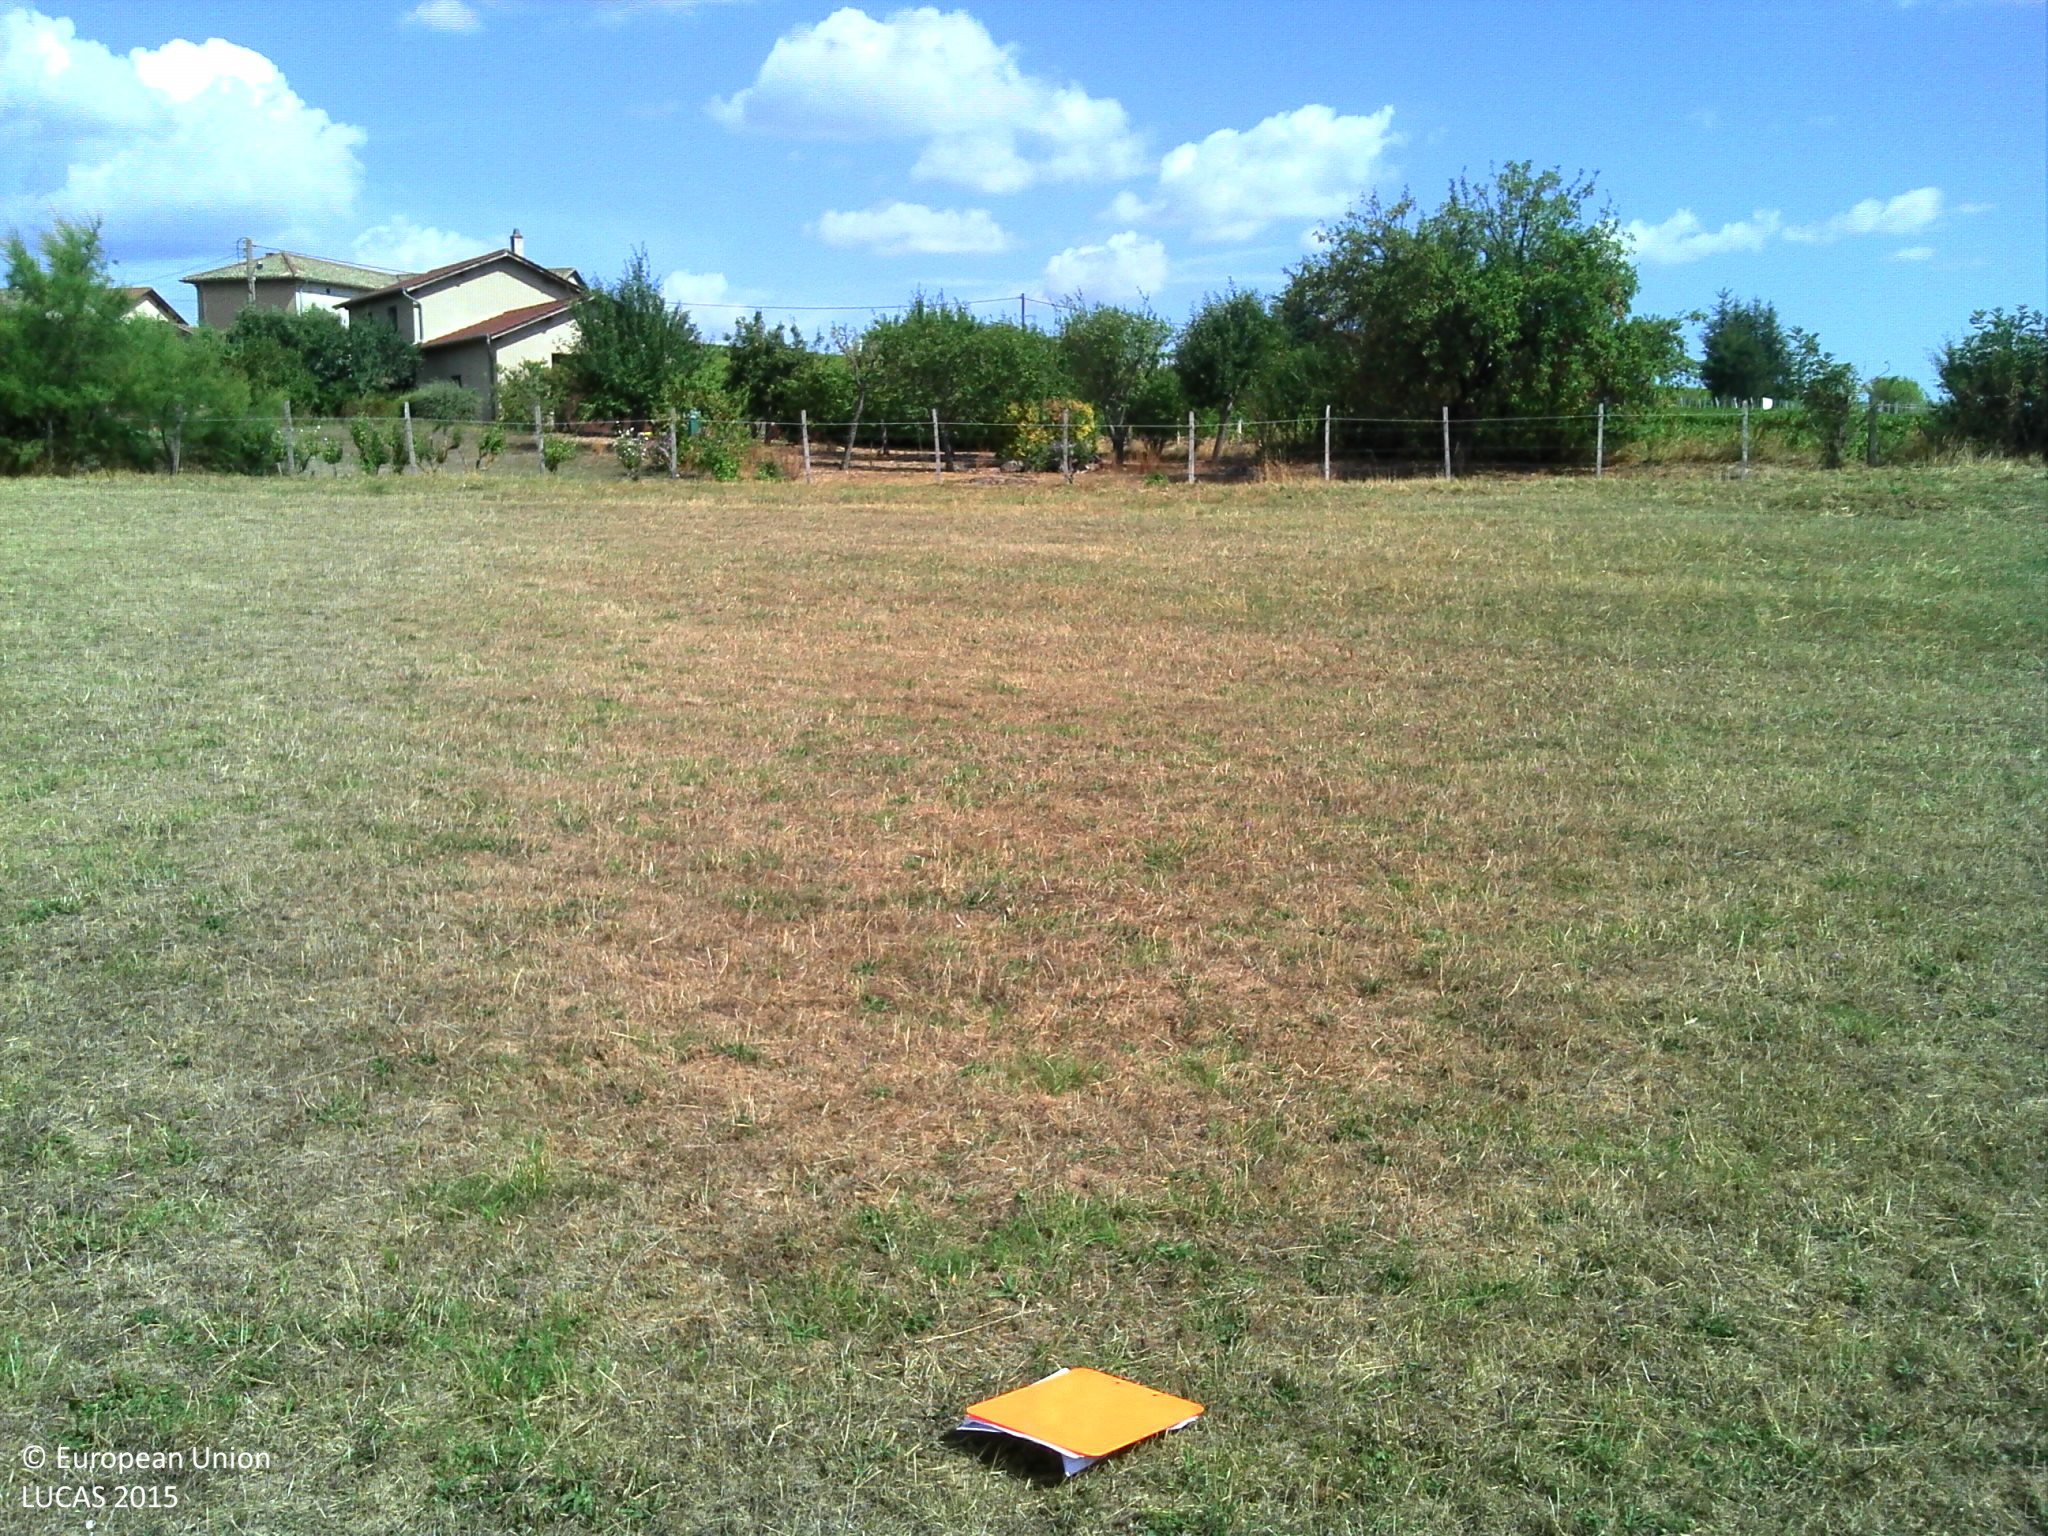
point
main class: Grassland
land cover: Grassland without tree/shrub cover
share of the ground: > 75 %
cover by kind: herbaceous plants 100 %
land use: Agriculture (excluding fallow land and kitchen gardens)
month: August
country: FR
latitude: 46.1454
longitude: 4.6555
